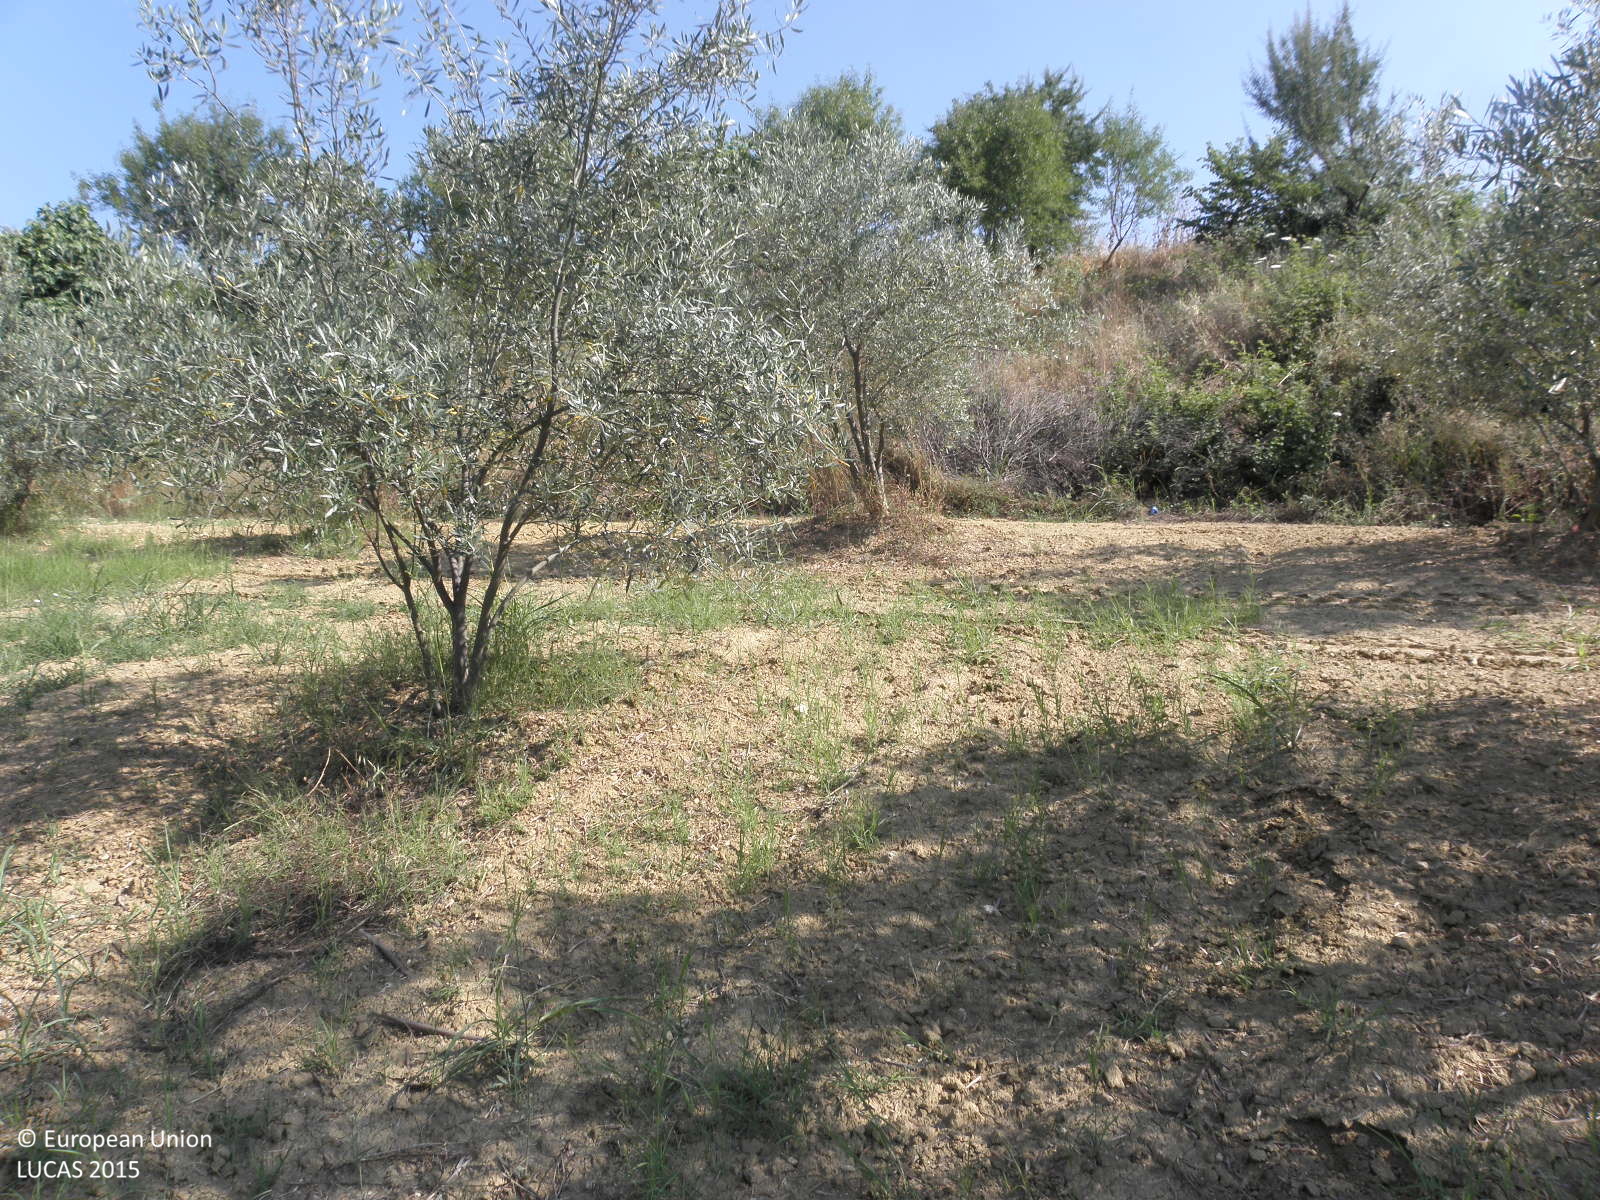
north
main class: Cropland
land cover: Olive groves
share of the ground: 25 - 50 %
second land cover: Grassland without tree/shrub cover
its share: 50 - 75 %
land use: Agriculture (excluding fallow land and kitchen gardens)
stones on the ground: < 10 %
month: June
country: GR
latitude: 40.3939
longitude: 22.5232
